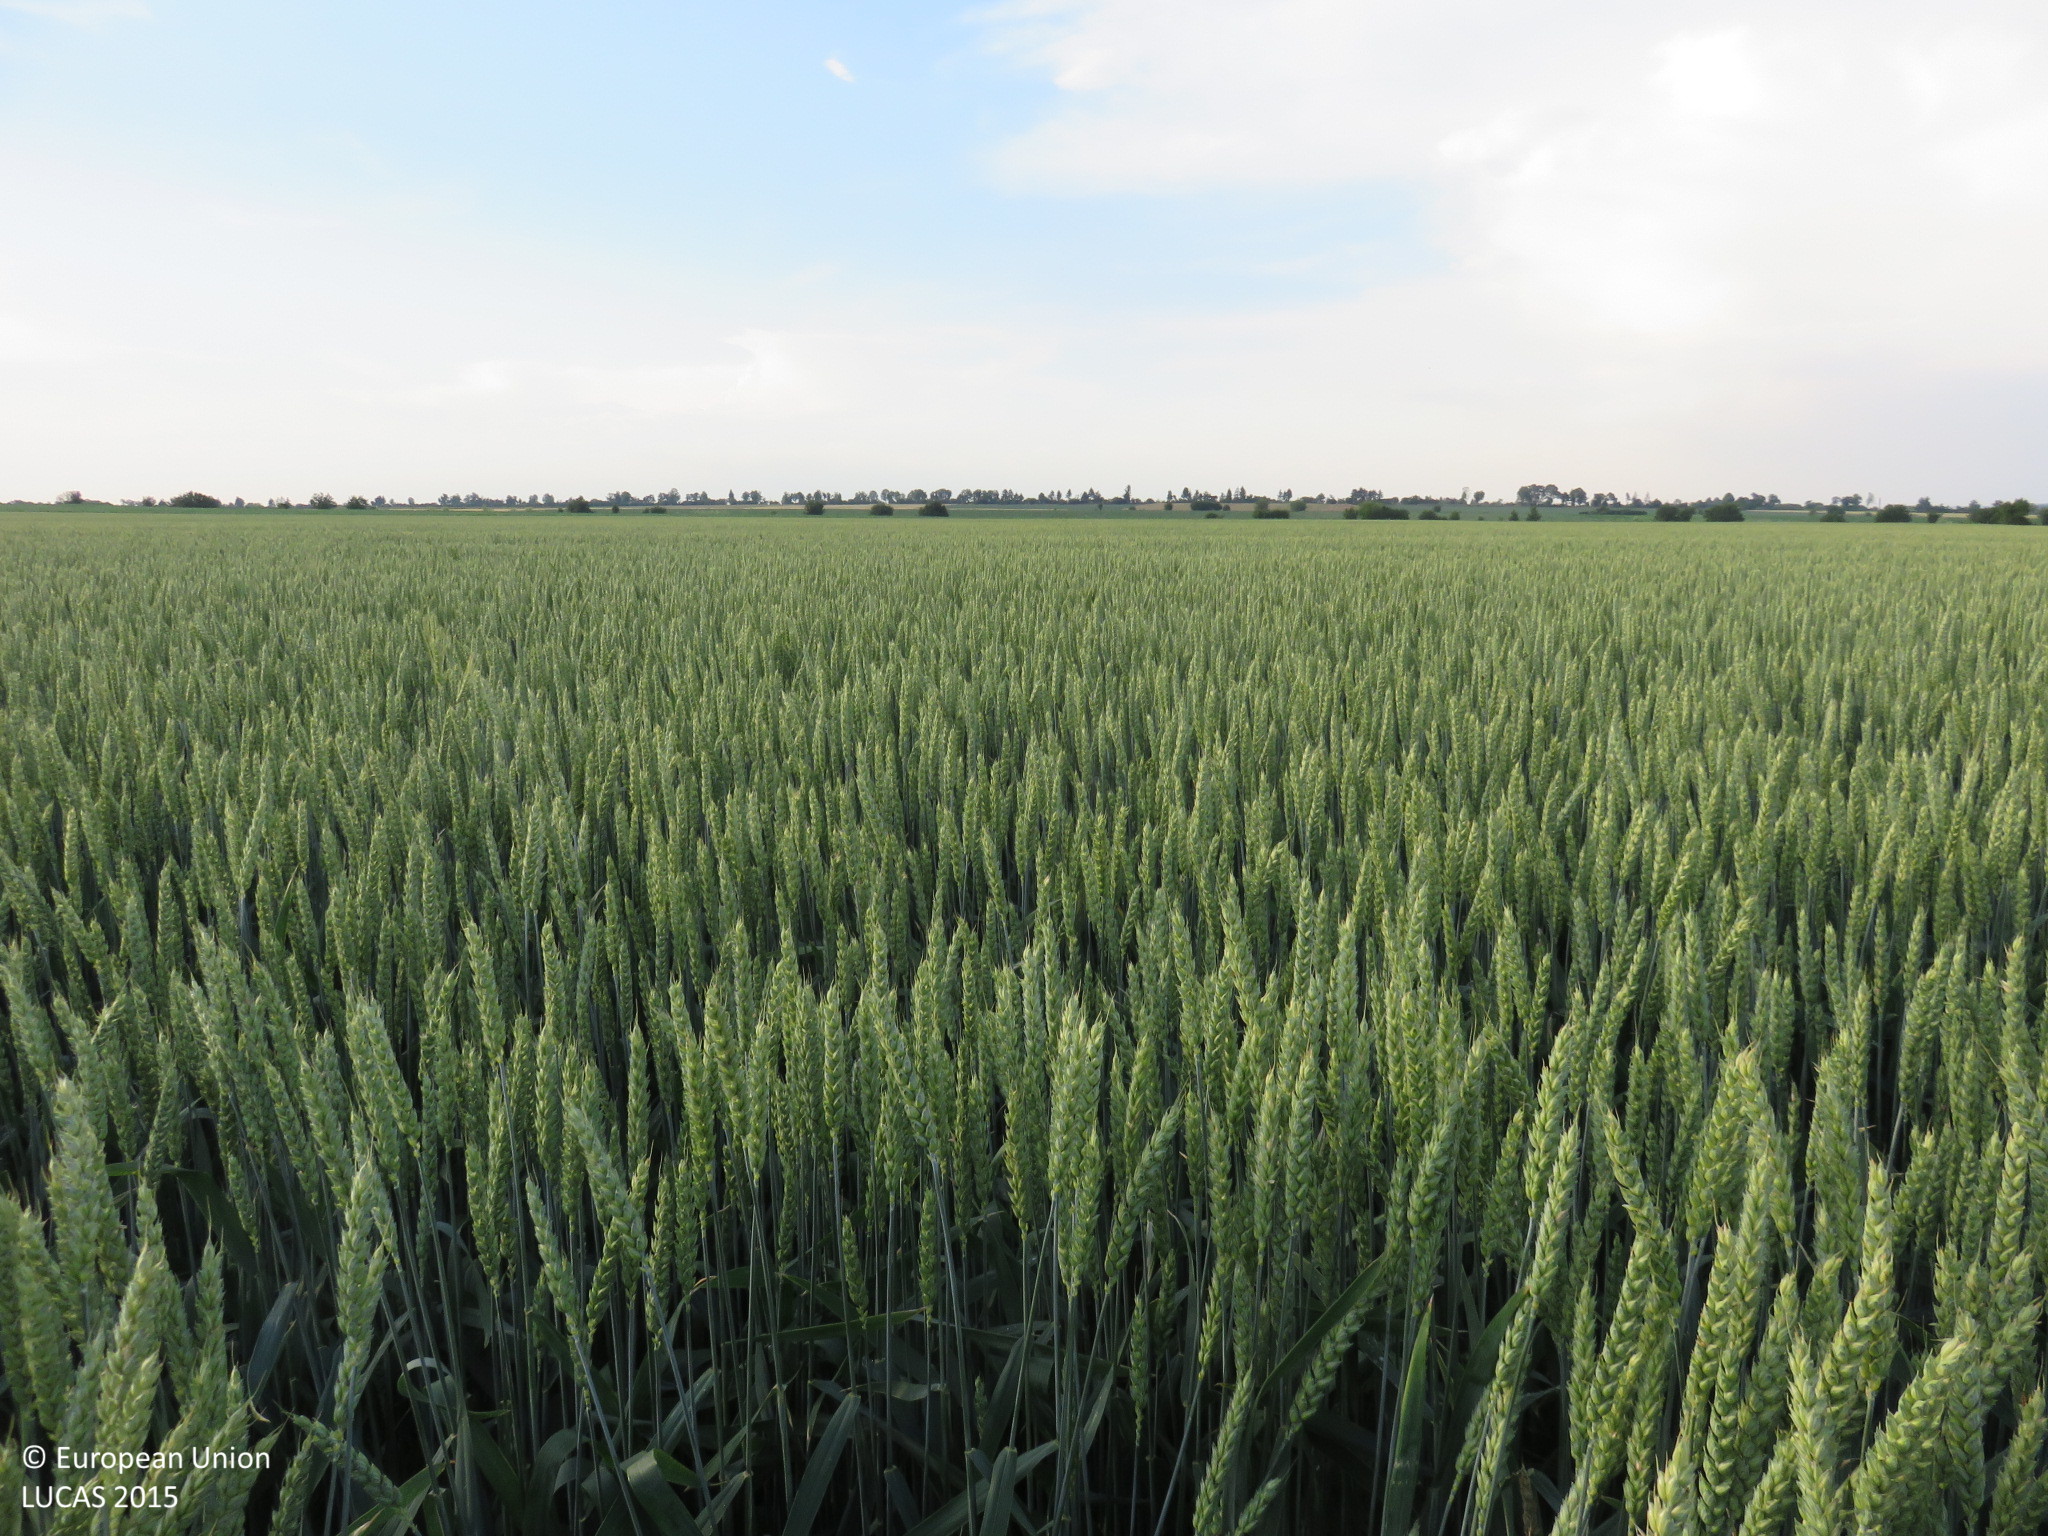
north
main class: Cropland
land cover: Common wheat
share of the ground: > 75 %
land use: Agriculture (excluding fallow land and kitchen gardens)
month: June
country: BG
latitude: 43.4351
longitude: 24.5032
